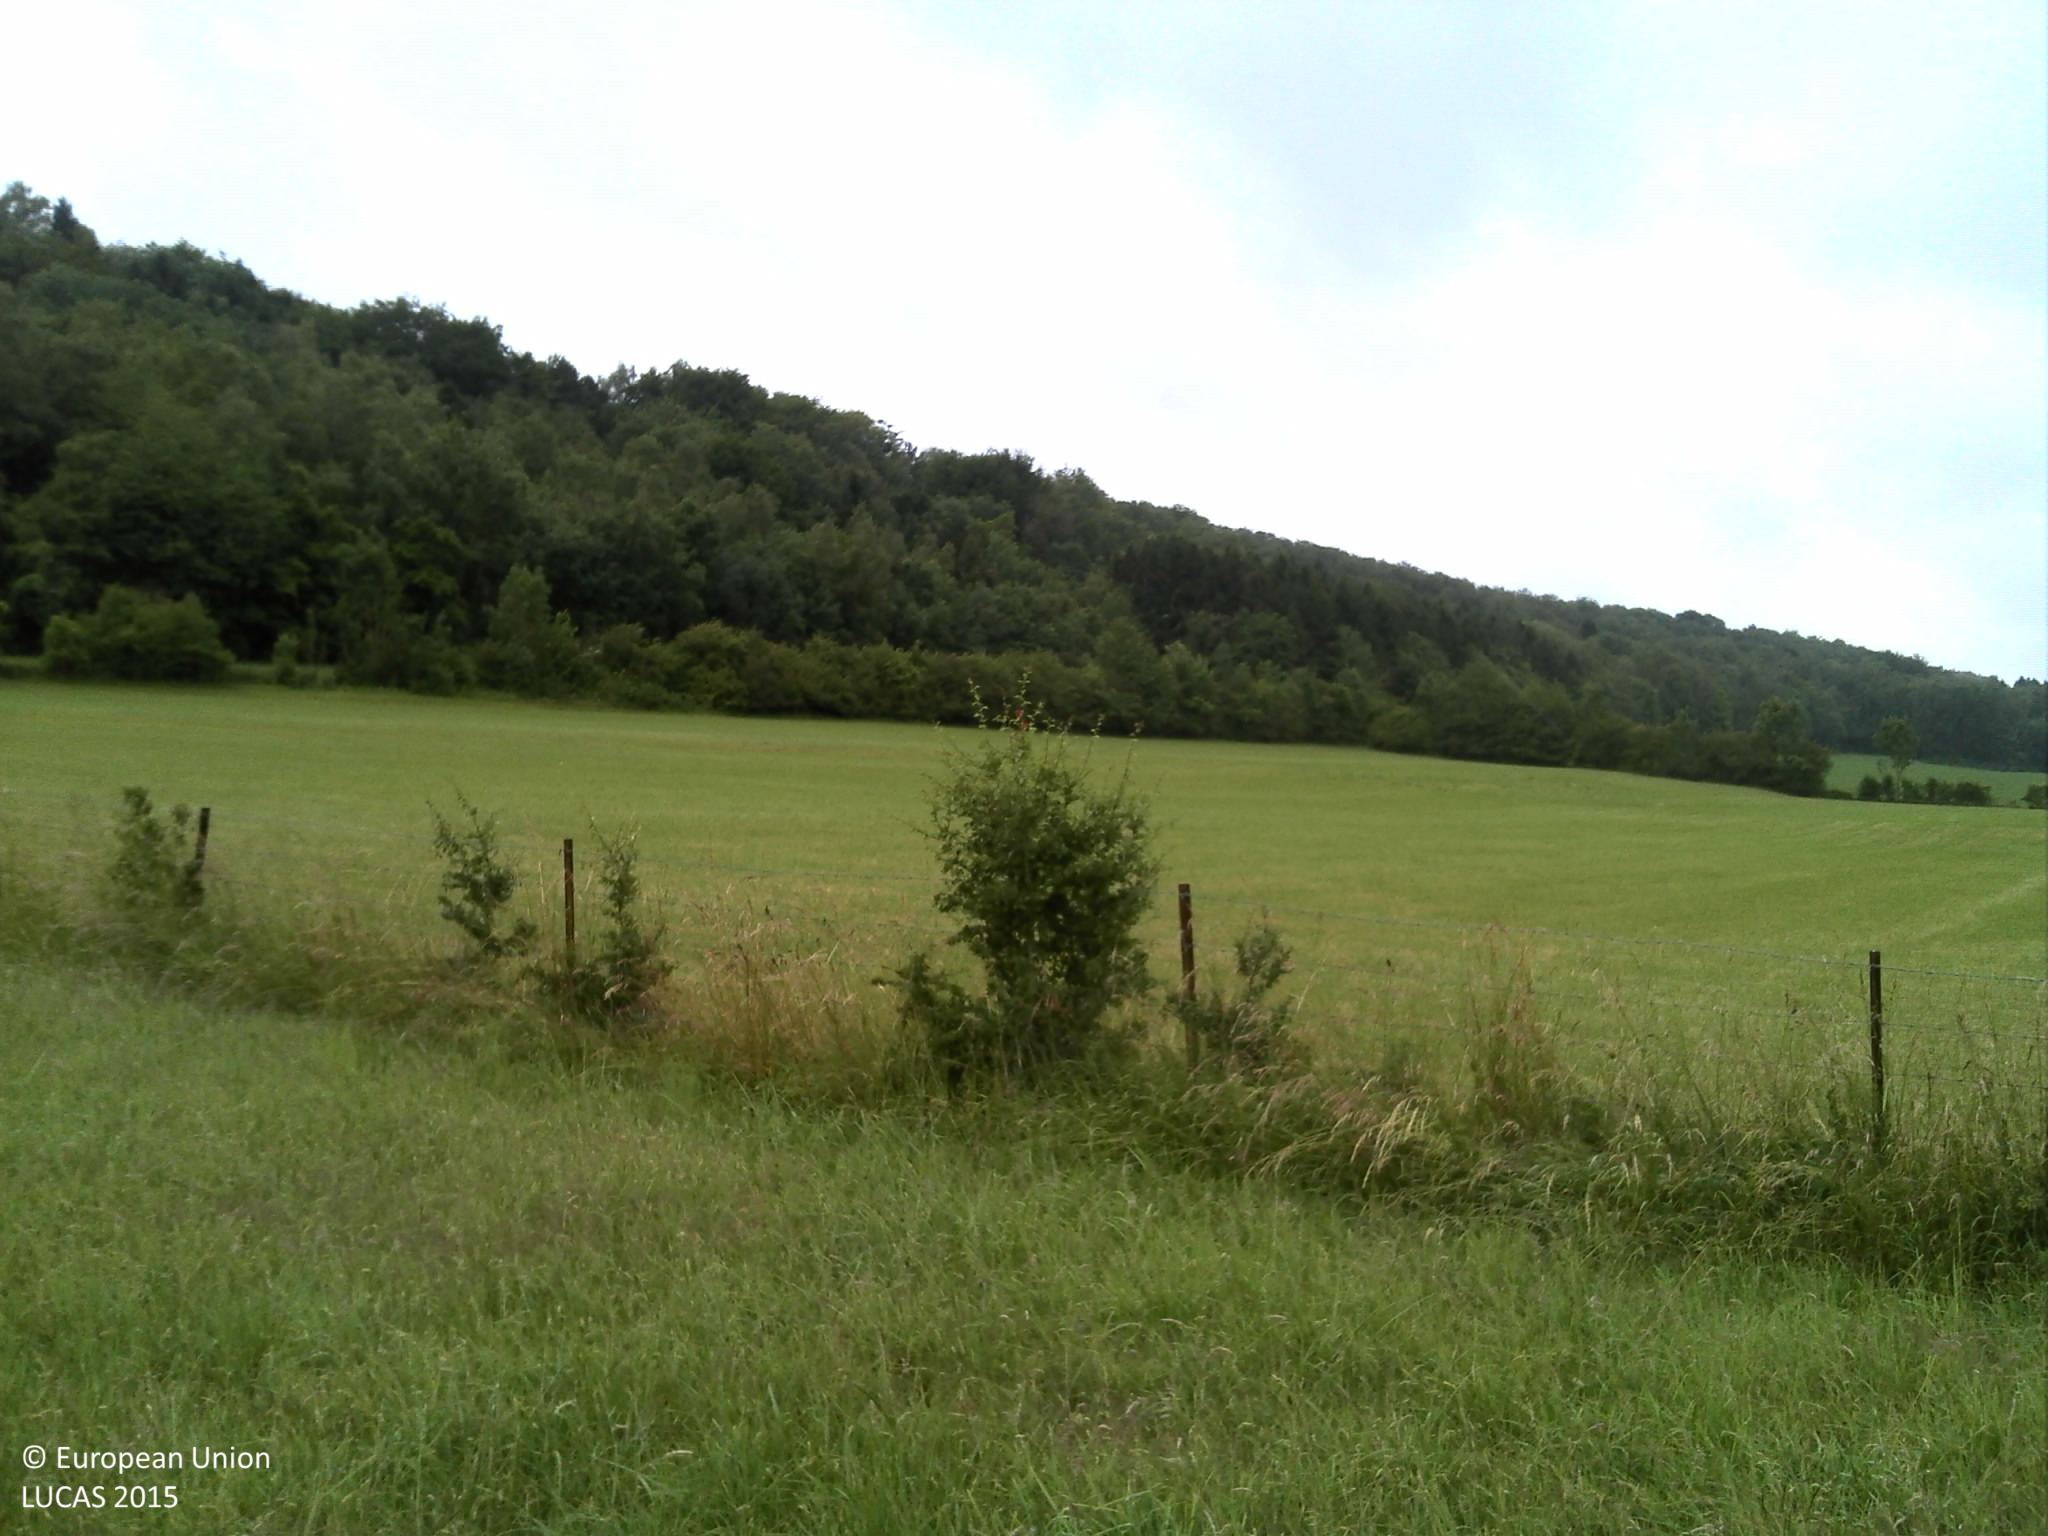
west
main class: Grassland
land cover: Grassland without tree/shrub cover
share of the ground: > 75 %
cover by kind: herbaceous plants 100 %
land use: Agriculture (excluding fallow land and kitchen gardens)
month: June
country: FR
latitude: 49.6872
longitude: 4.7990
